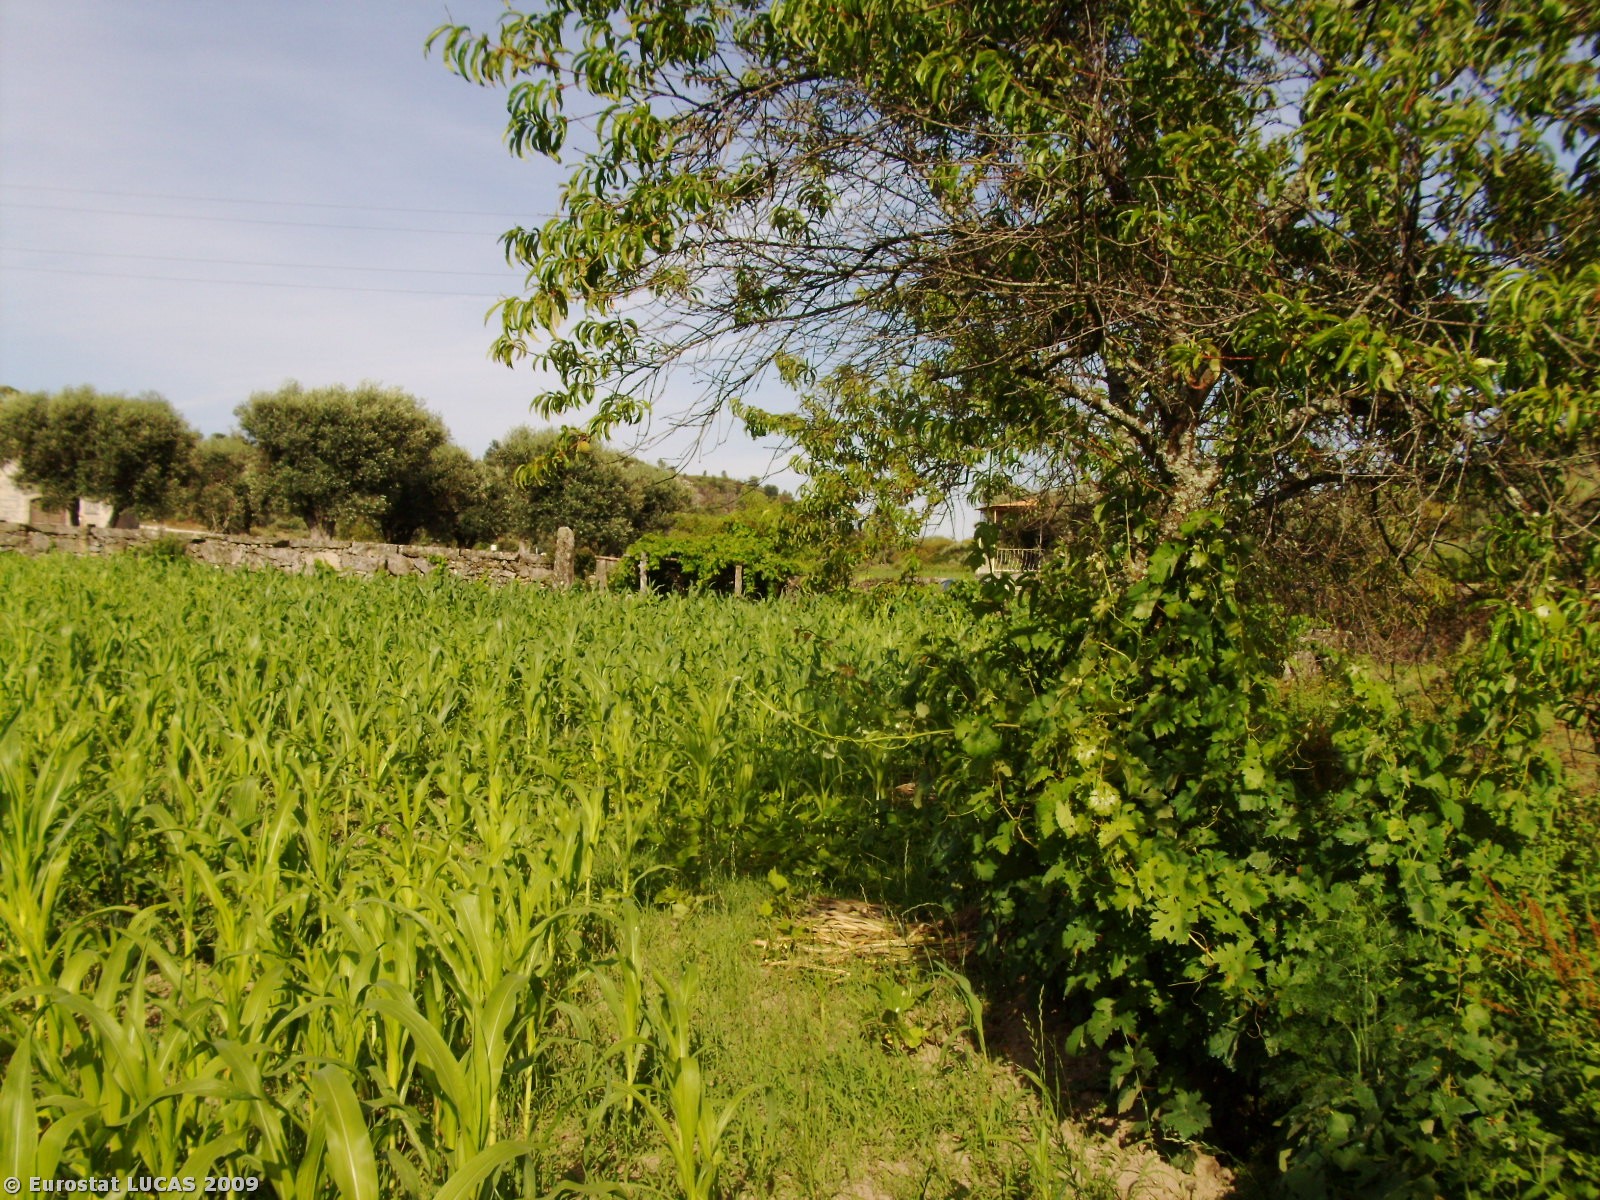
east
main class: Cropland
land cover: Maize
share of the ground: > 75 %
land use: Agriculture (excluding fallow land and kitchen gardens)
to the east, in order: Maize; Dry stone walls; Tracks; Artificial constructions in urban areas; Paved roads, cycling and walking lanes; Spontaneously vegetated surfaces; Dry stone walls; Maize; Fences; Dry stone walls; Other structural elements; Dry stone walls; Spontaneously vegetated surfaces; Electric lines; Spontaneously vegetated surfaces; Dry stone walls; Paved roads, cycling and walking lanes; Grass margins; Dry stone walls; Potatoes; Maize
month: July
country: PT
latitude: 40.5715
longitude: -7.6575
